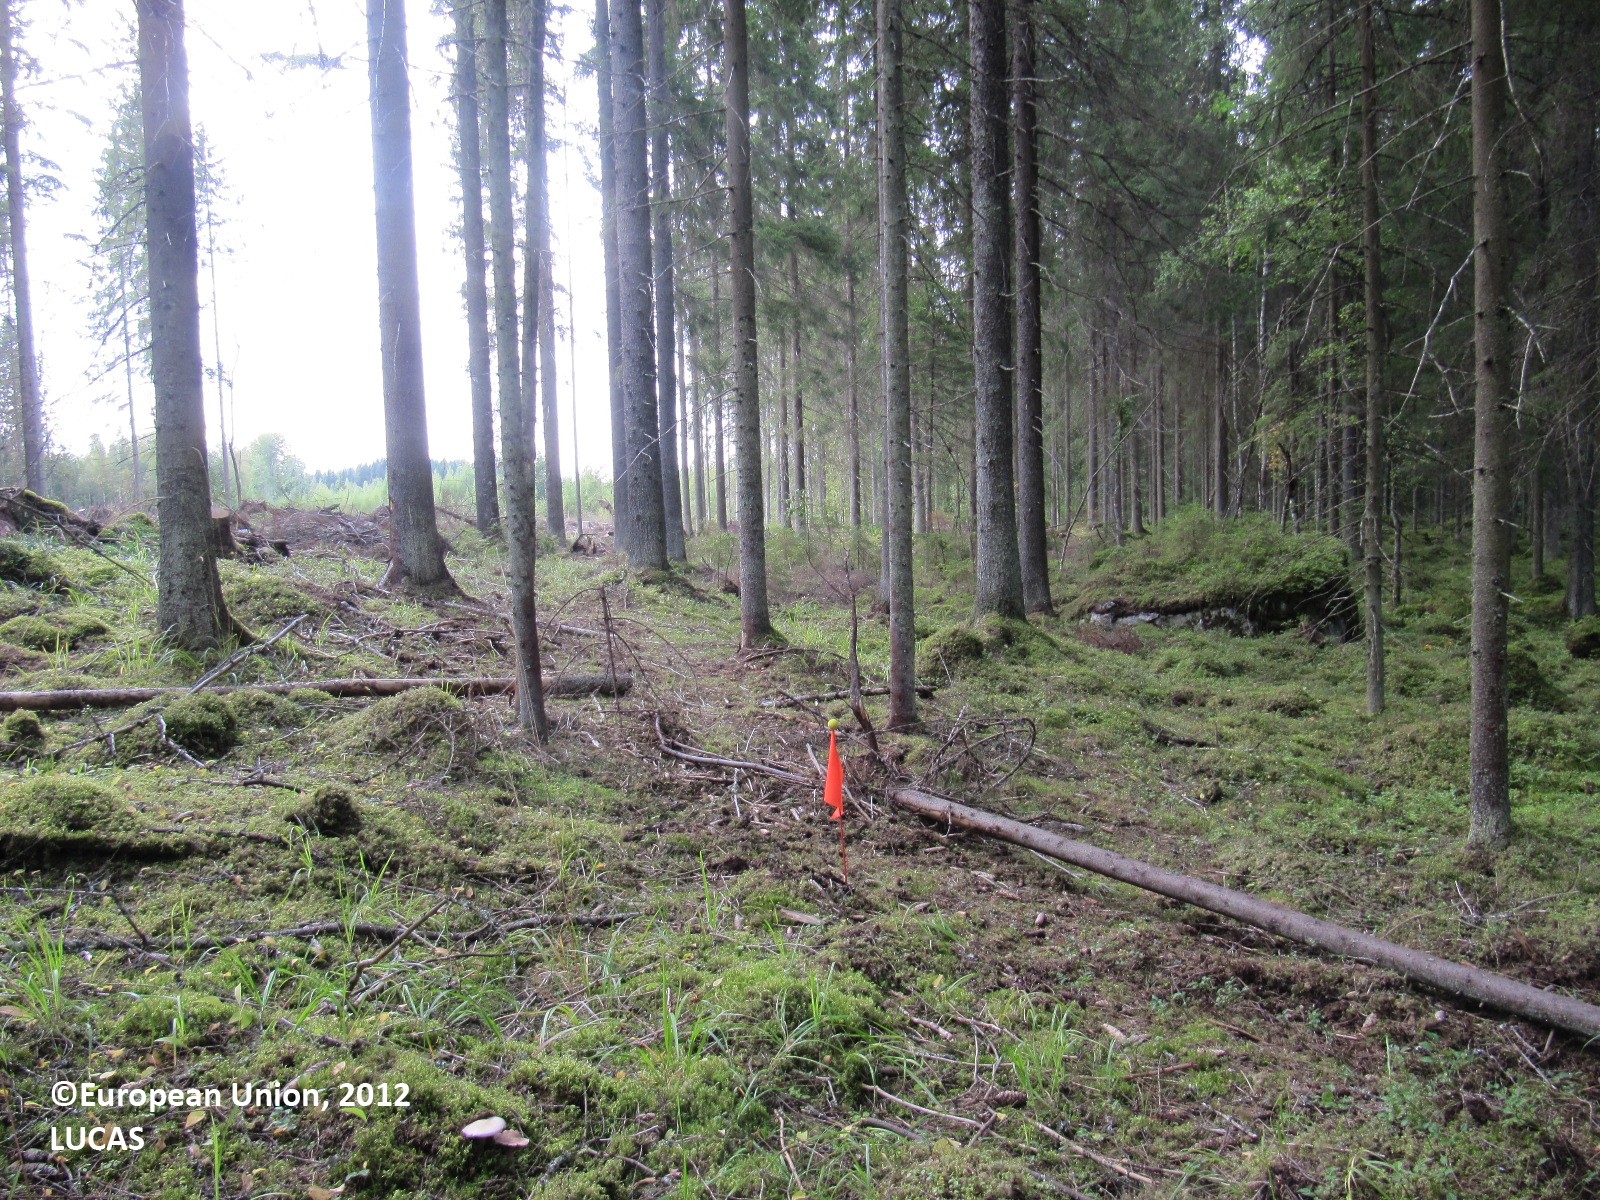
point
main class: Woodland
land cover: Spruce dominated coniferous woodland
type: boreal forest
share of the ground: > 75 %
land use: Forestry
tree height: > 5 m
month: August
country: FI
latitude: 61.0506
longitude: 22.8697
